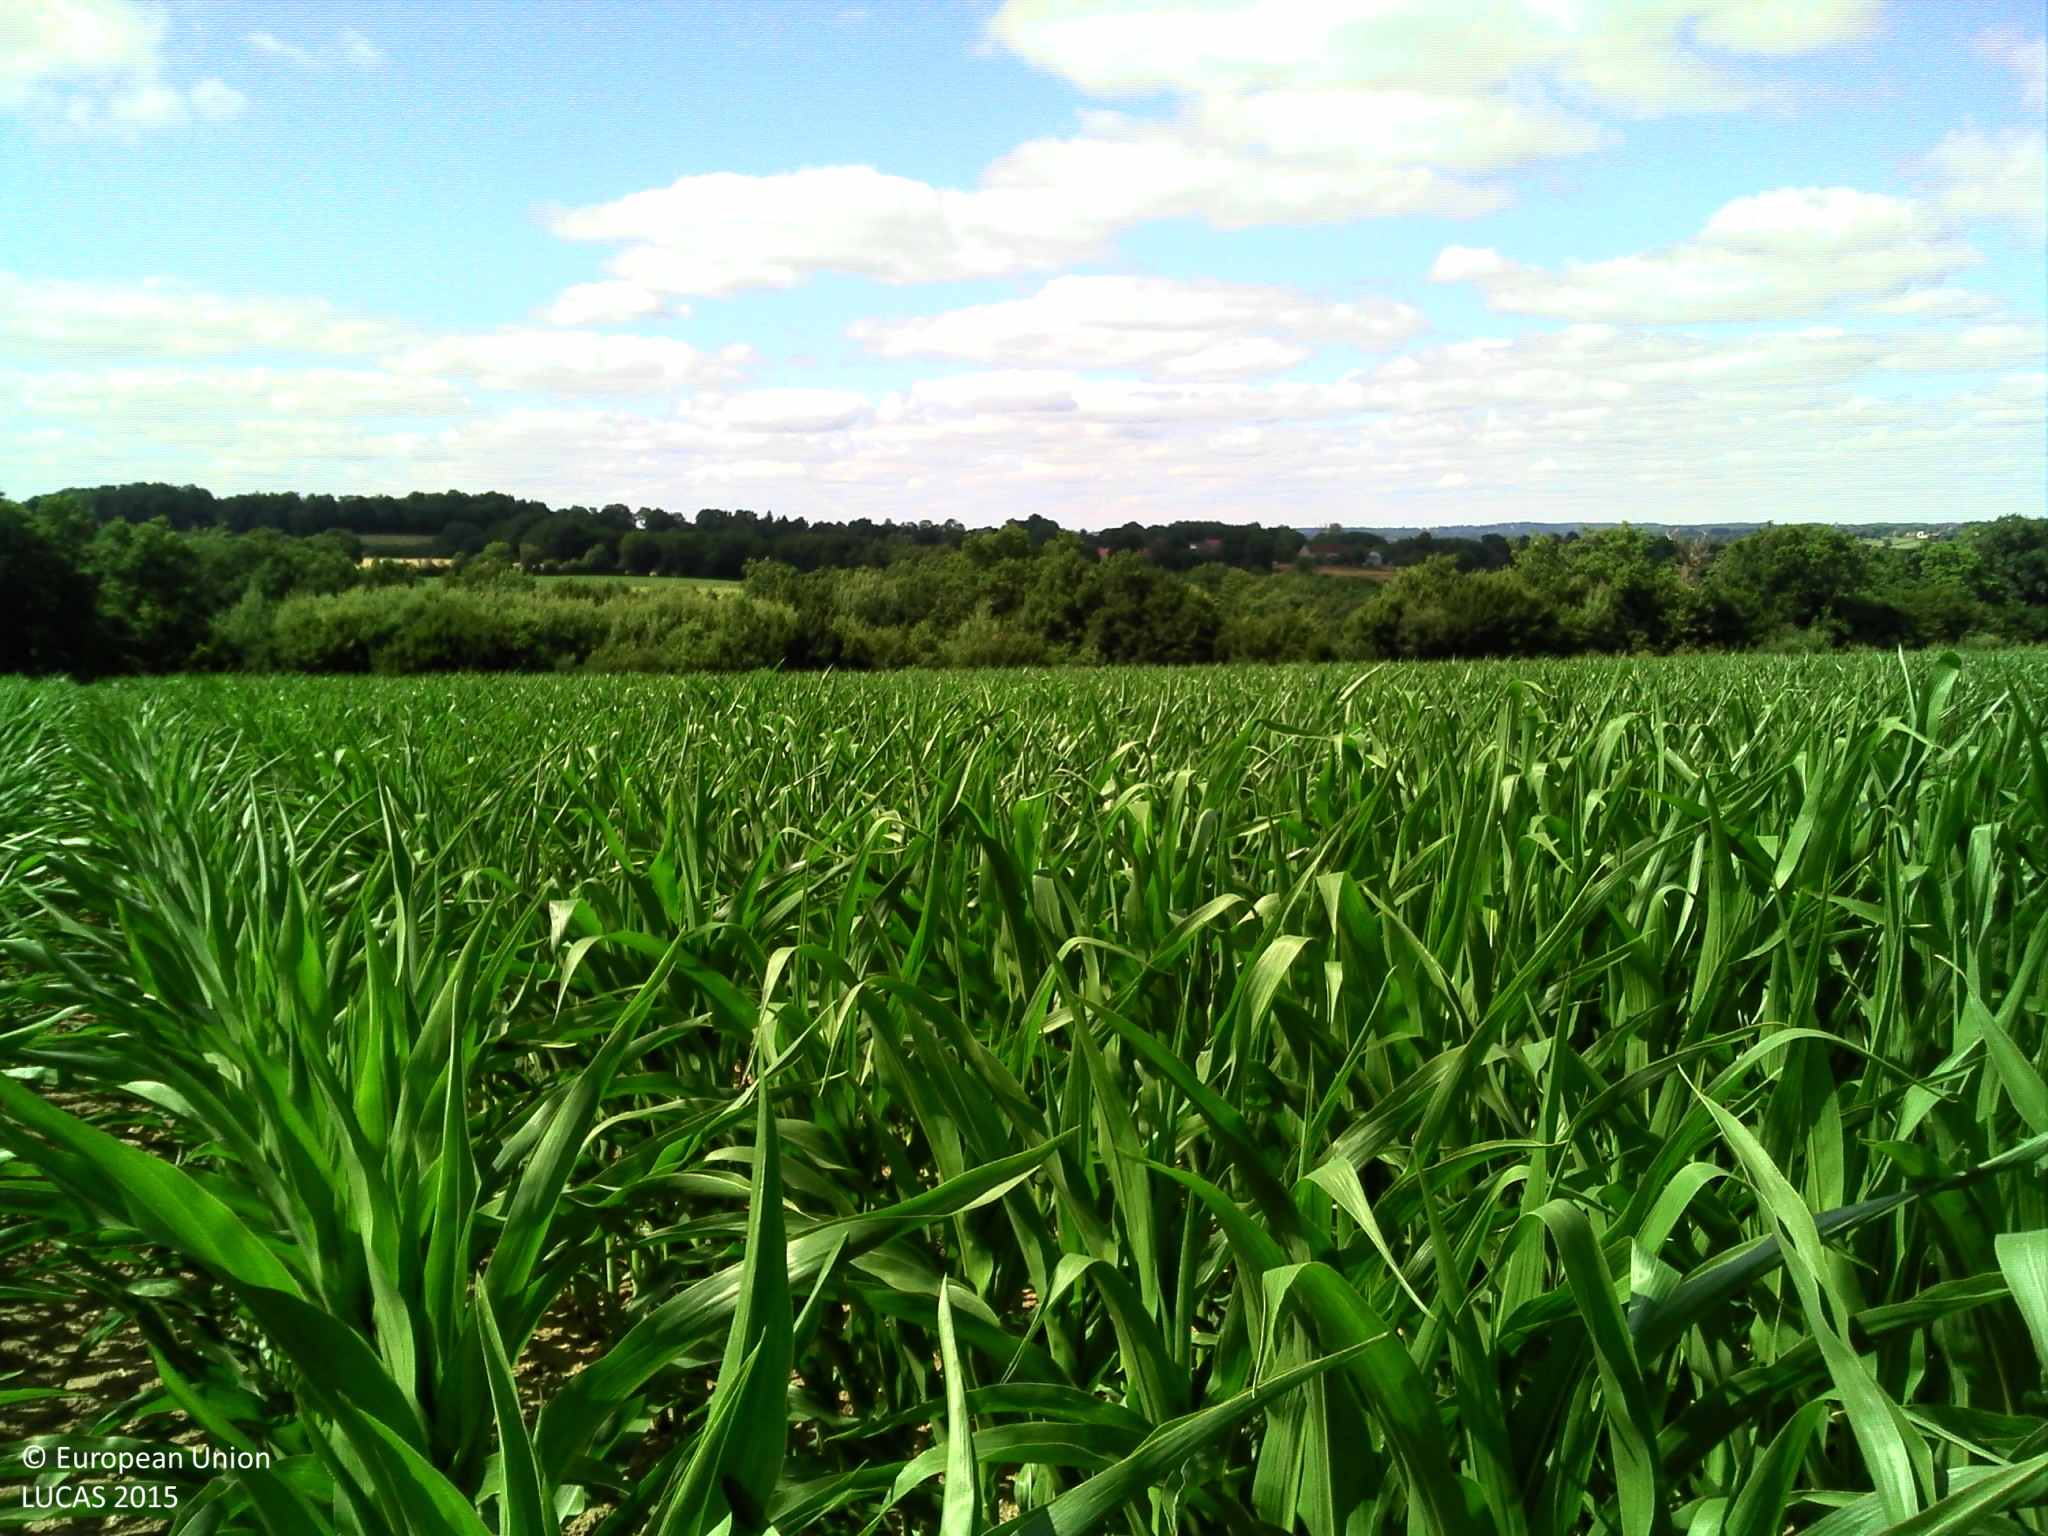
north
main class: Cropland
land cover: Maize
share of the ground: > 75 %
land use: Agriculture (excluding fallow land and kitchen gardens)
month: July
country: FR
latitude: 46.3193
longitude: 1.7187
